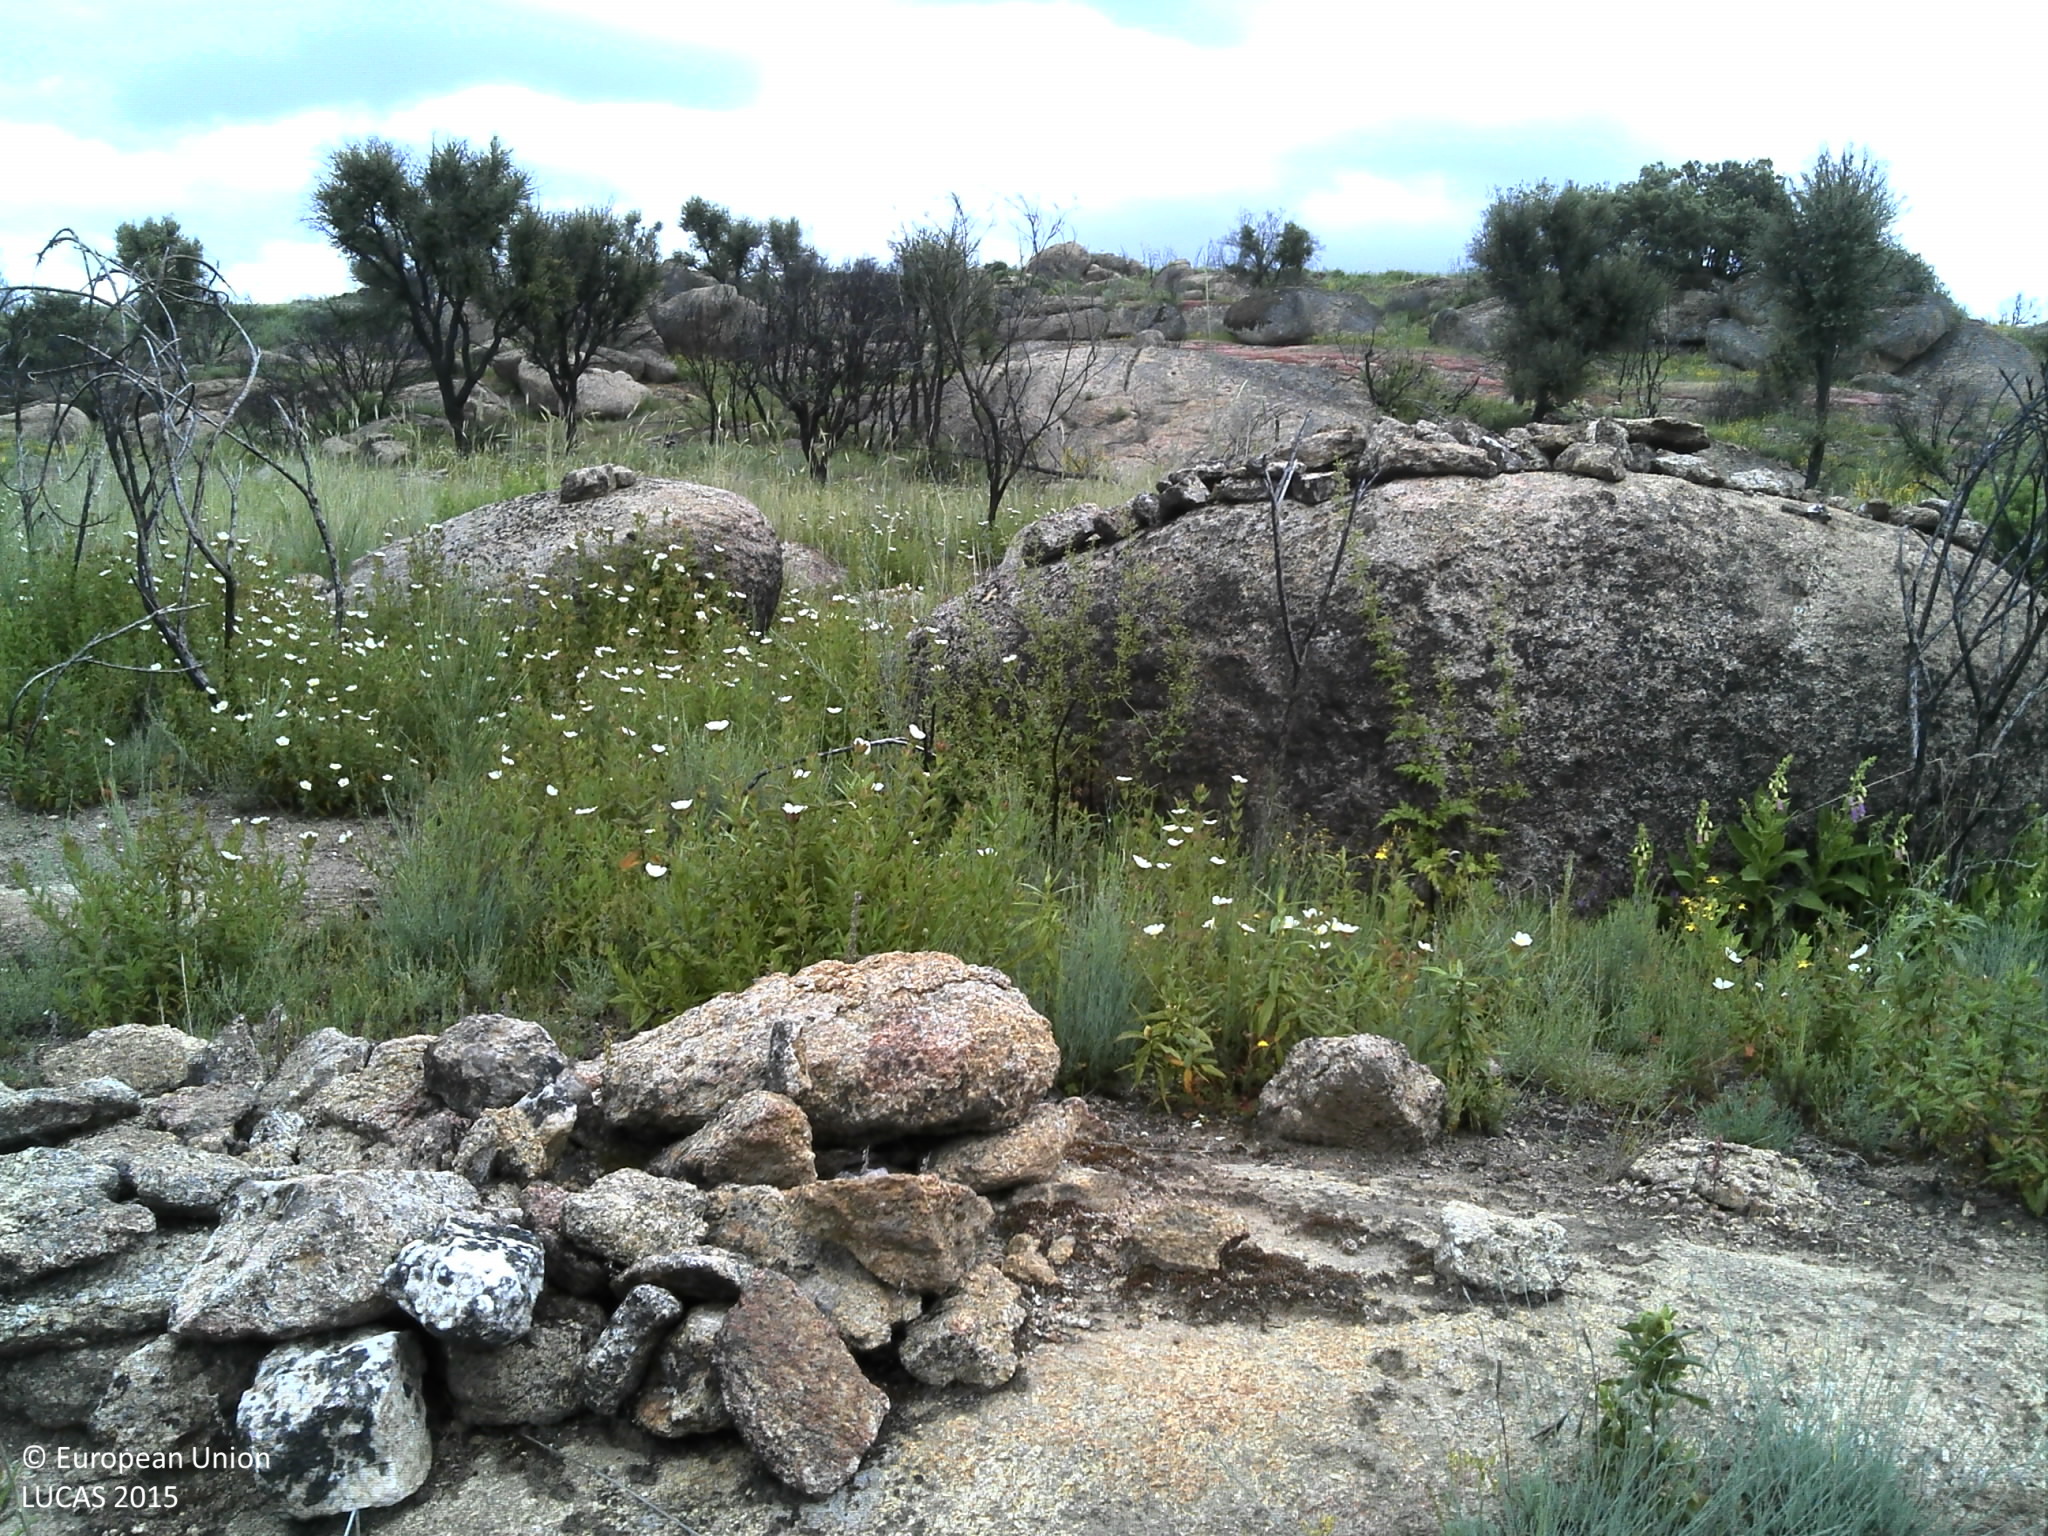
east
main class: Shrubland
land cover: Shrubland with sparse tree cover
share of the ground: 50 - 75 %
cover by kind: shrubs 50 %, consolidated bare surface 45 %, broadleaved forest trees 5 %
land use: Forestry
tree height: < 5 m
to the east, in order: Shrubland with sparse tree cover; Spontaneously vegetated surfaces; Broadleaved woodland; Rock outcrops; Broadleaved woodland; Rock outcrops; Spontaneously vegetated surfaces; Rye
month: May
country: PT
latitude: 41.6677
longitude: -7.0902
